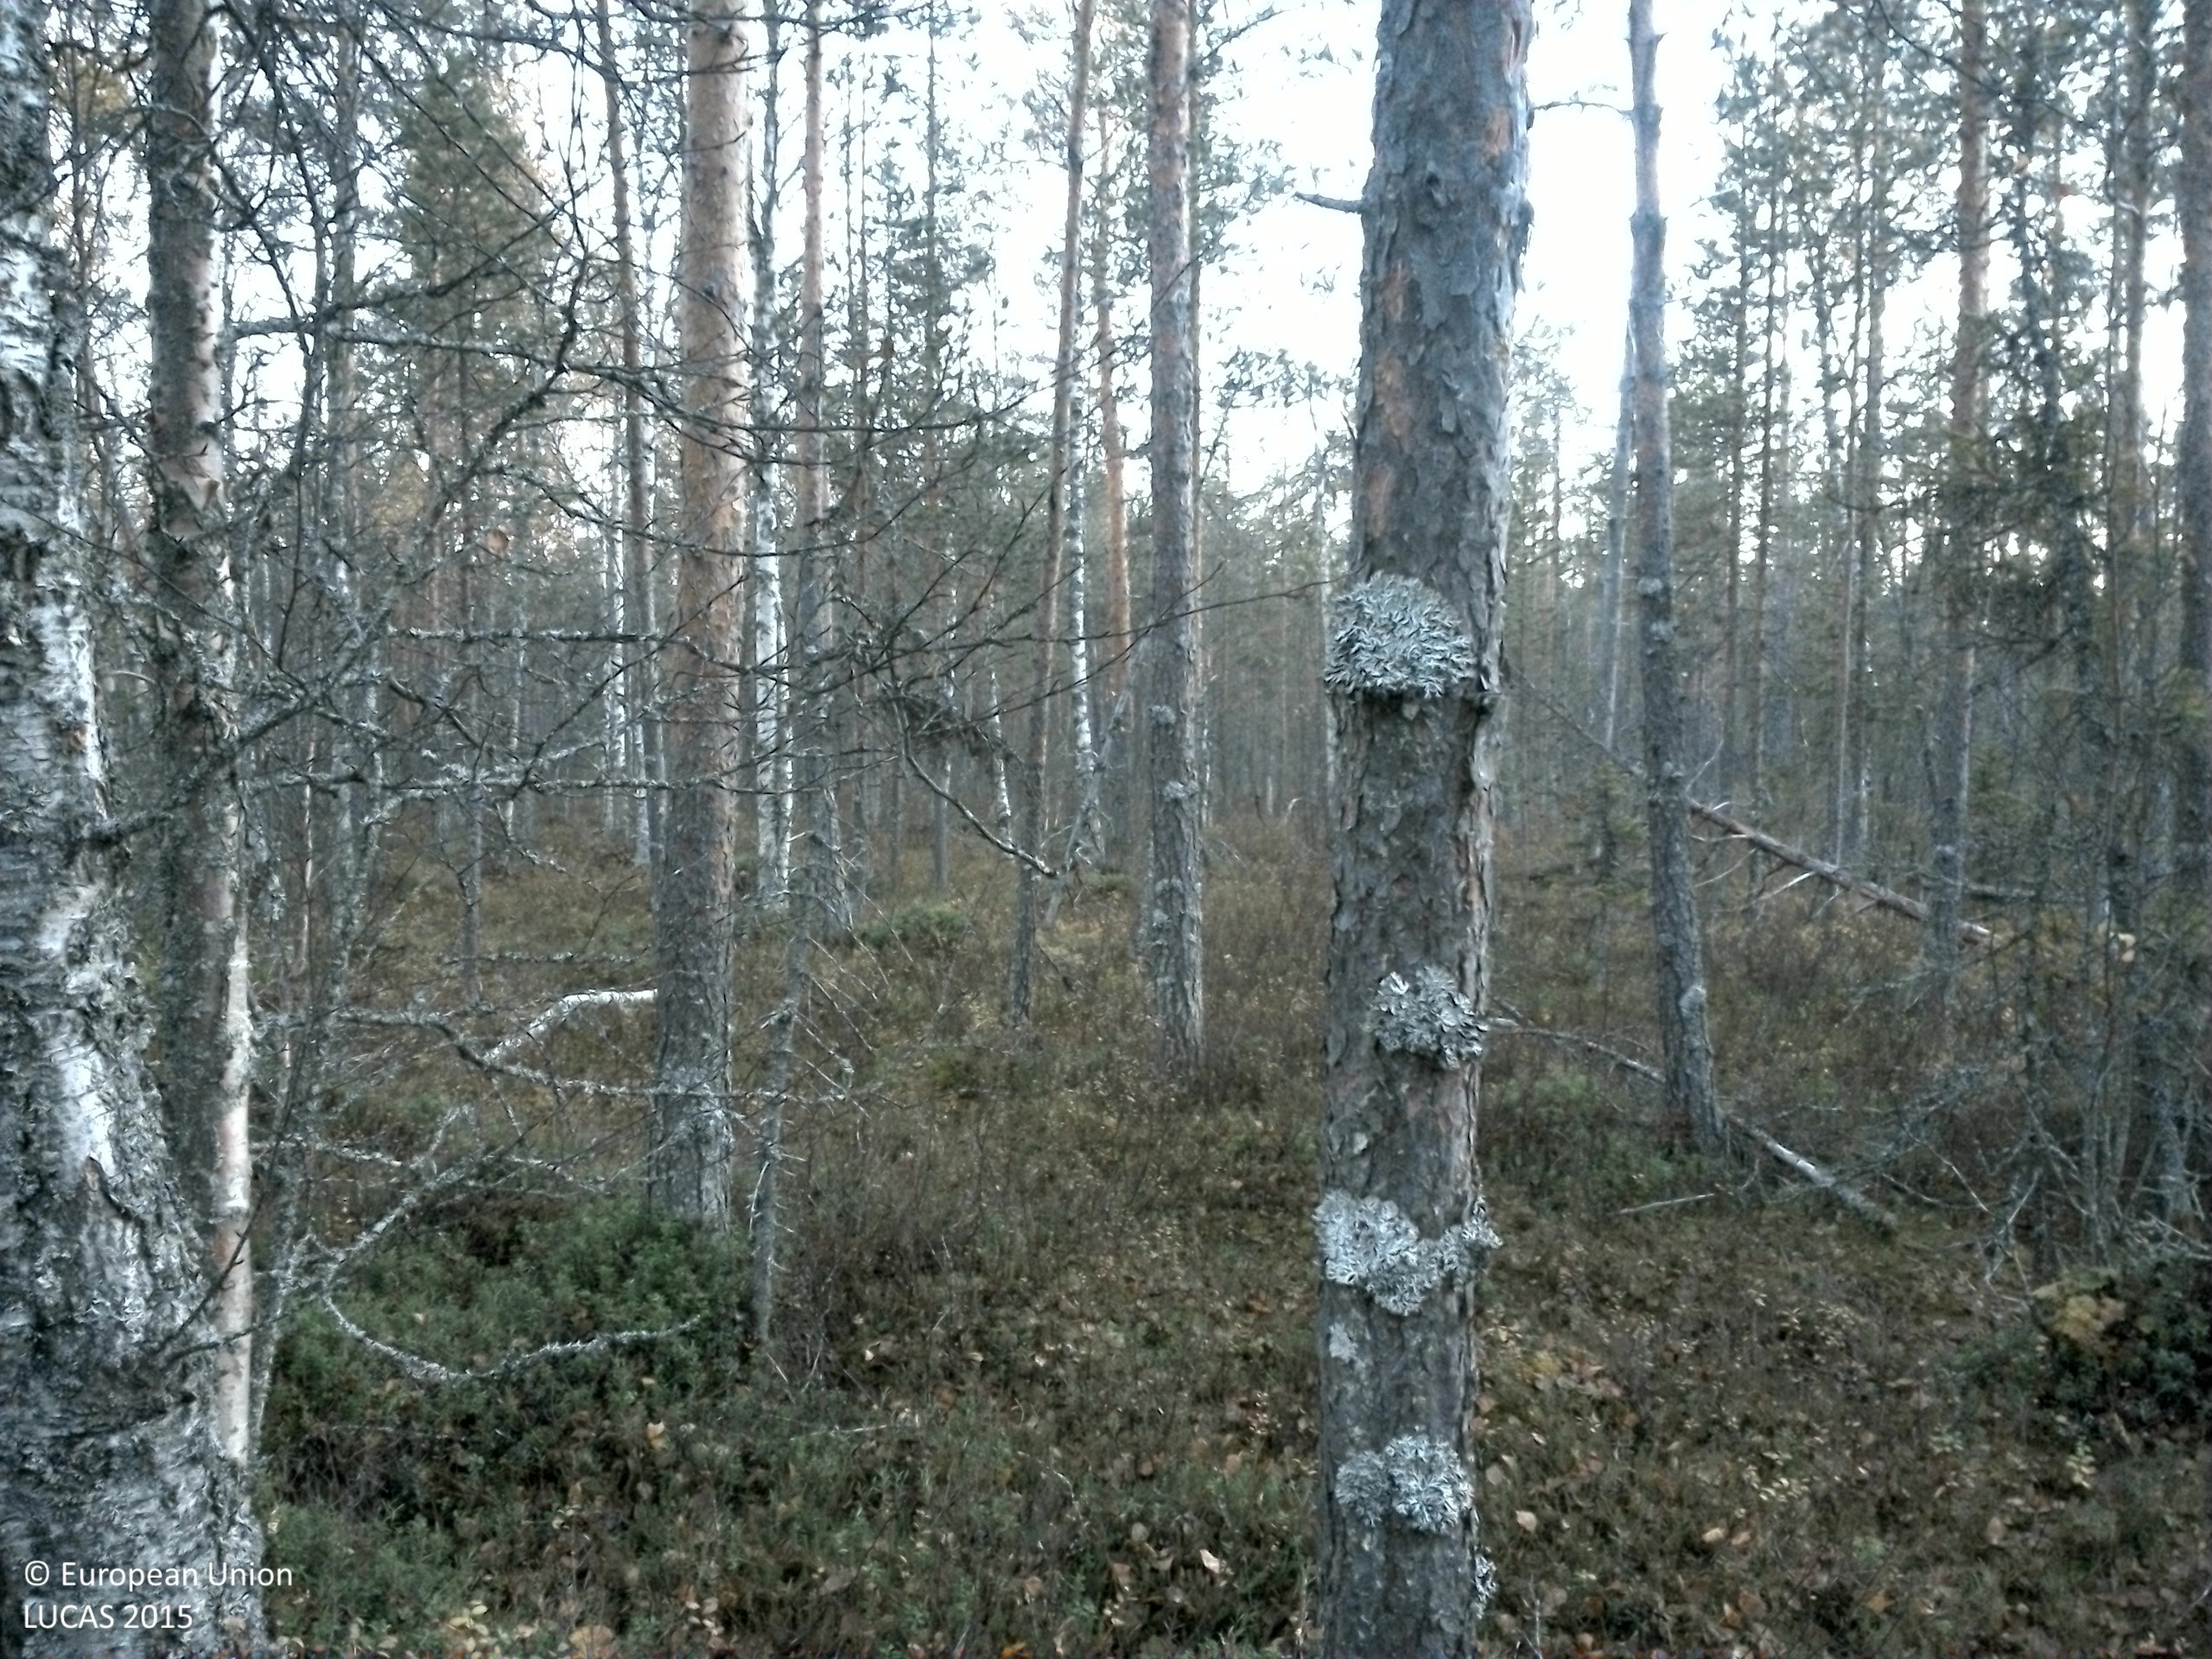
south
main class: Woodland
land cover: Pine dominated coniferous woodland
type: boreal forest
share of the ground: 25 - 50 %
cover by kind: shrubs 45 %, coniferous forest trees 35 %, broadleaved forest trees 10 %, lichens and mosses 10 %
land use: Forestry
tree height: > 5 m
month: September
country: SE
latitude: 64.2531
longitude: 16.3451
